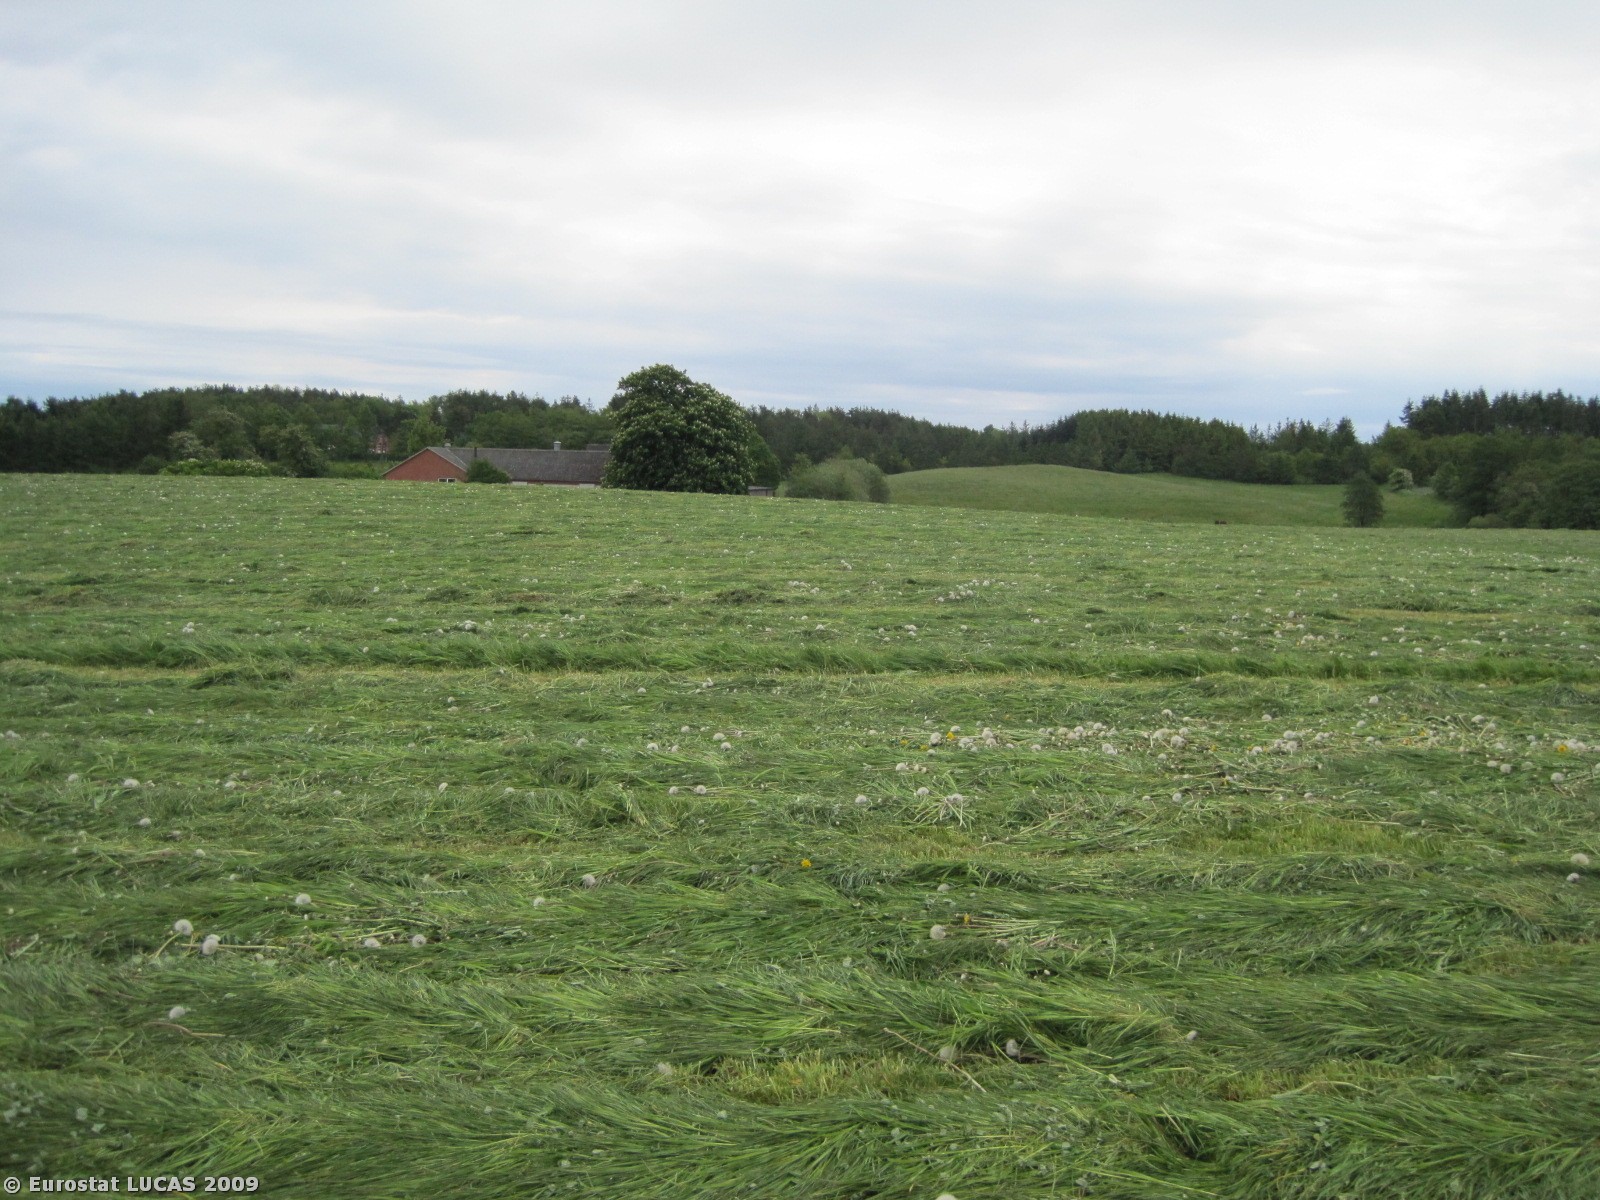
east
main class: Grassland
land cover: Grassland without tree/shrub cover
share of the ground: > 75 %
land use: Agriculture (excluding fallow land and kitchen gardens)
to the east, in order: Grassland without tree/shrub cover; Artificial constructions in urban areas; Grassland without tree/shrub cover; Managed hedges; Fences; Grassland without tree/shrub cover
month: May
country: DK
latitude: 56.7450
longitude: 10.0816
